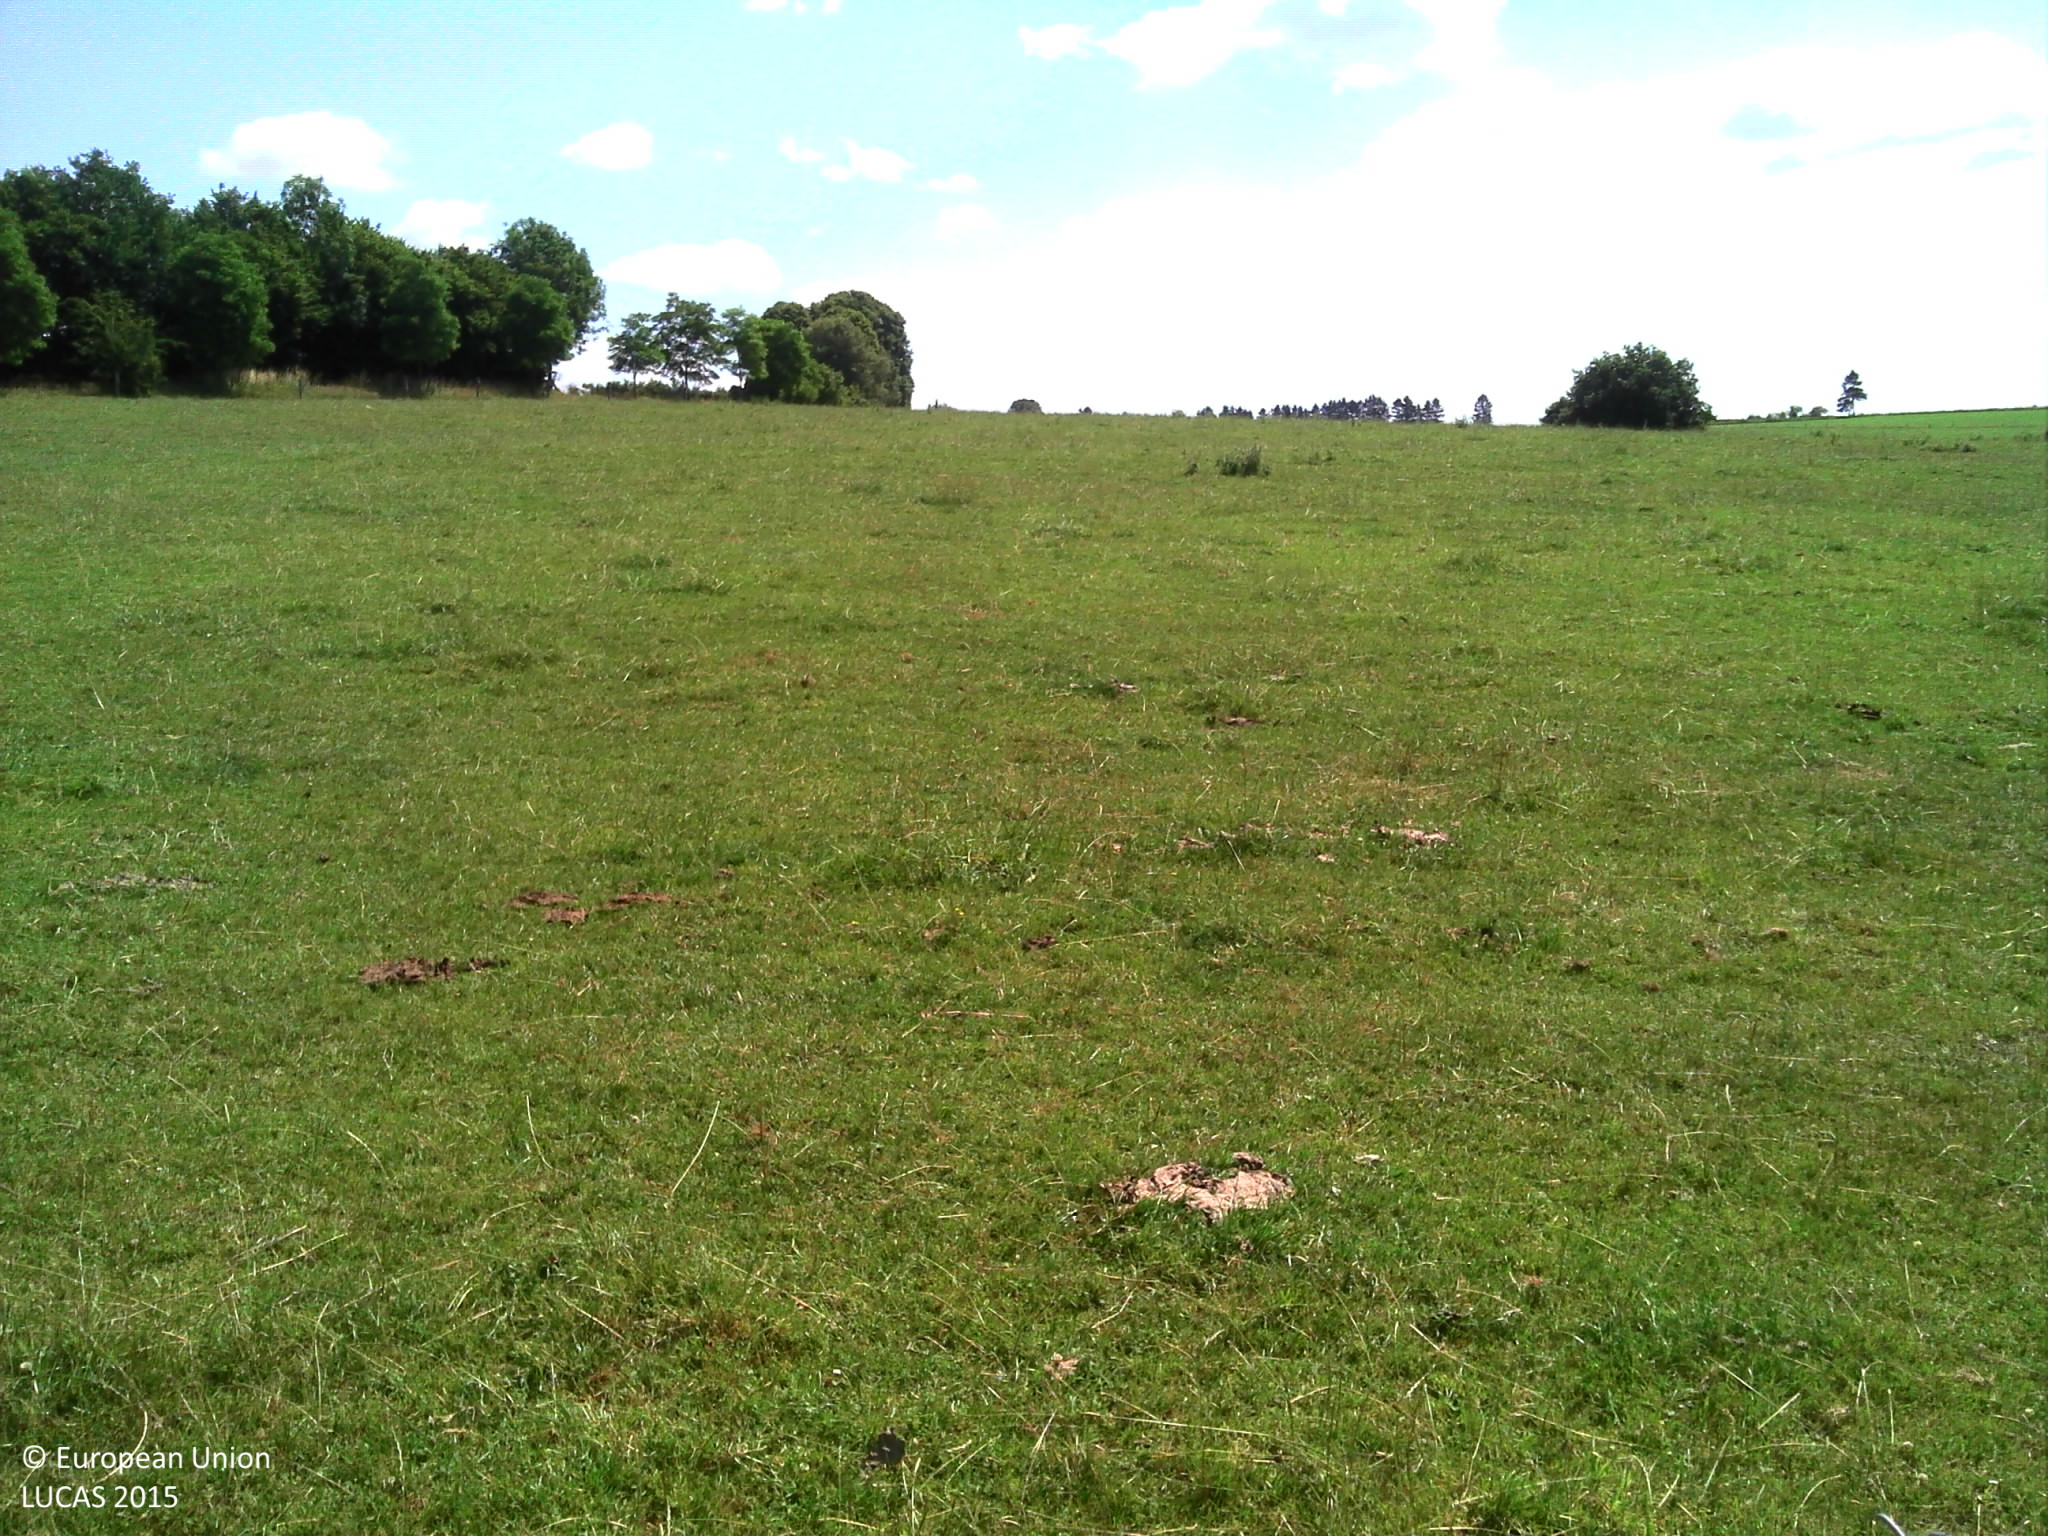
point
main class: Grassland
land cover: Grassland without tree/shrub cover
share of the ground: > 75 %
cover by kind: herbaceous plants 100 %
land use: Agriculture (excluding fallow land and kitchen gardens)
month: July
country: BE
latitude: 50.0158
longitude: 5.7702
